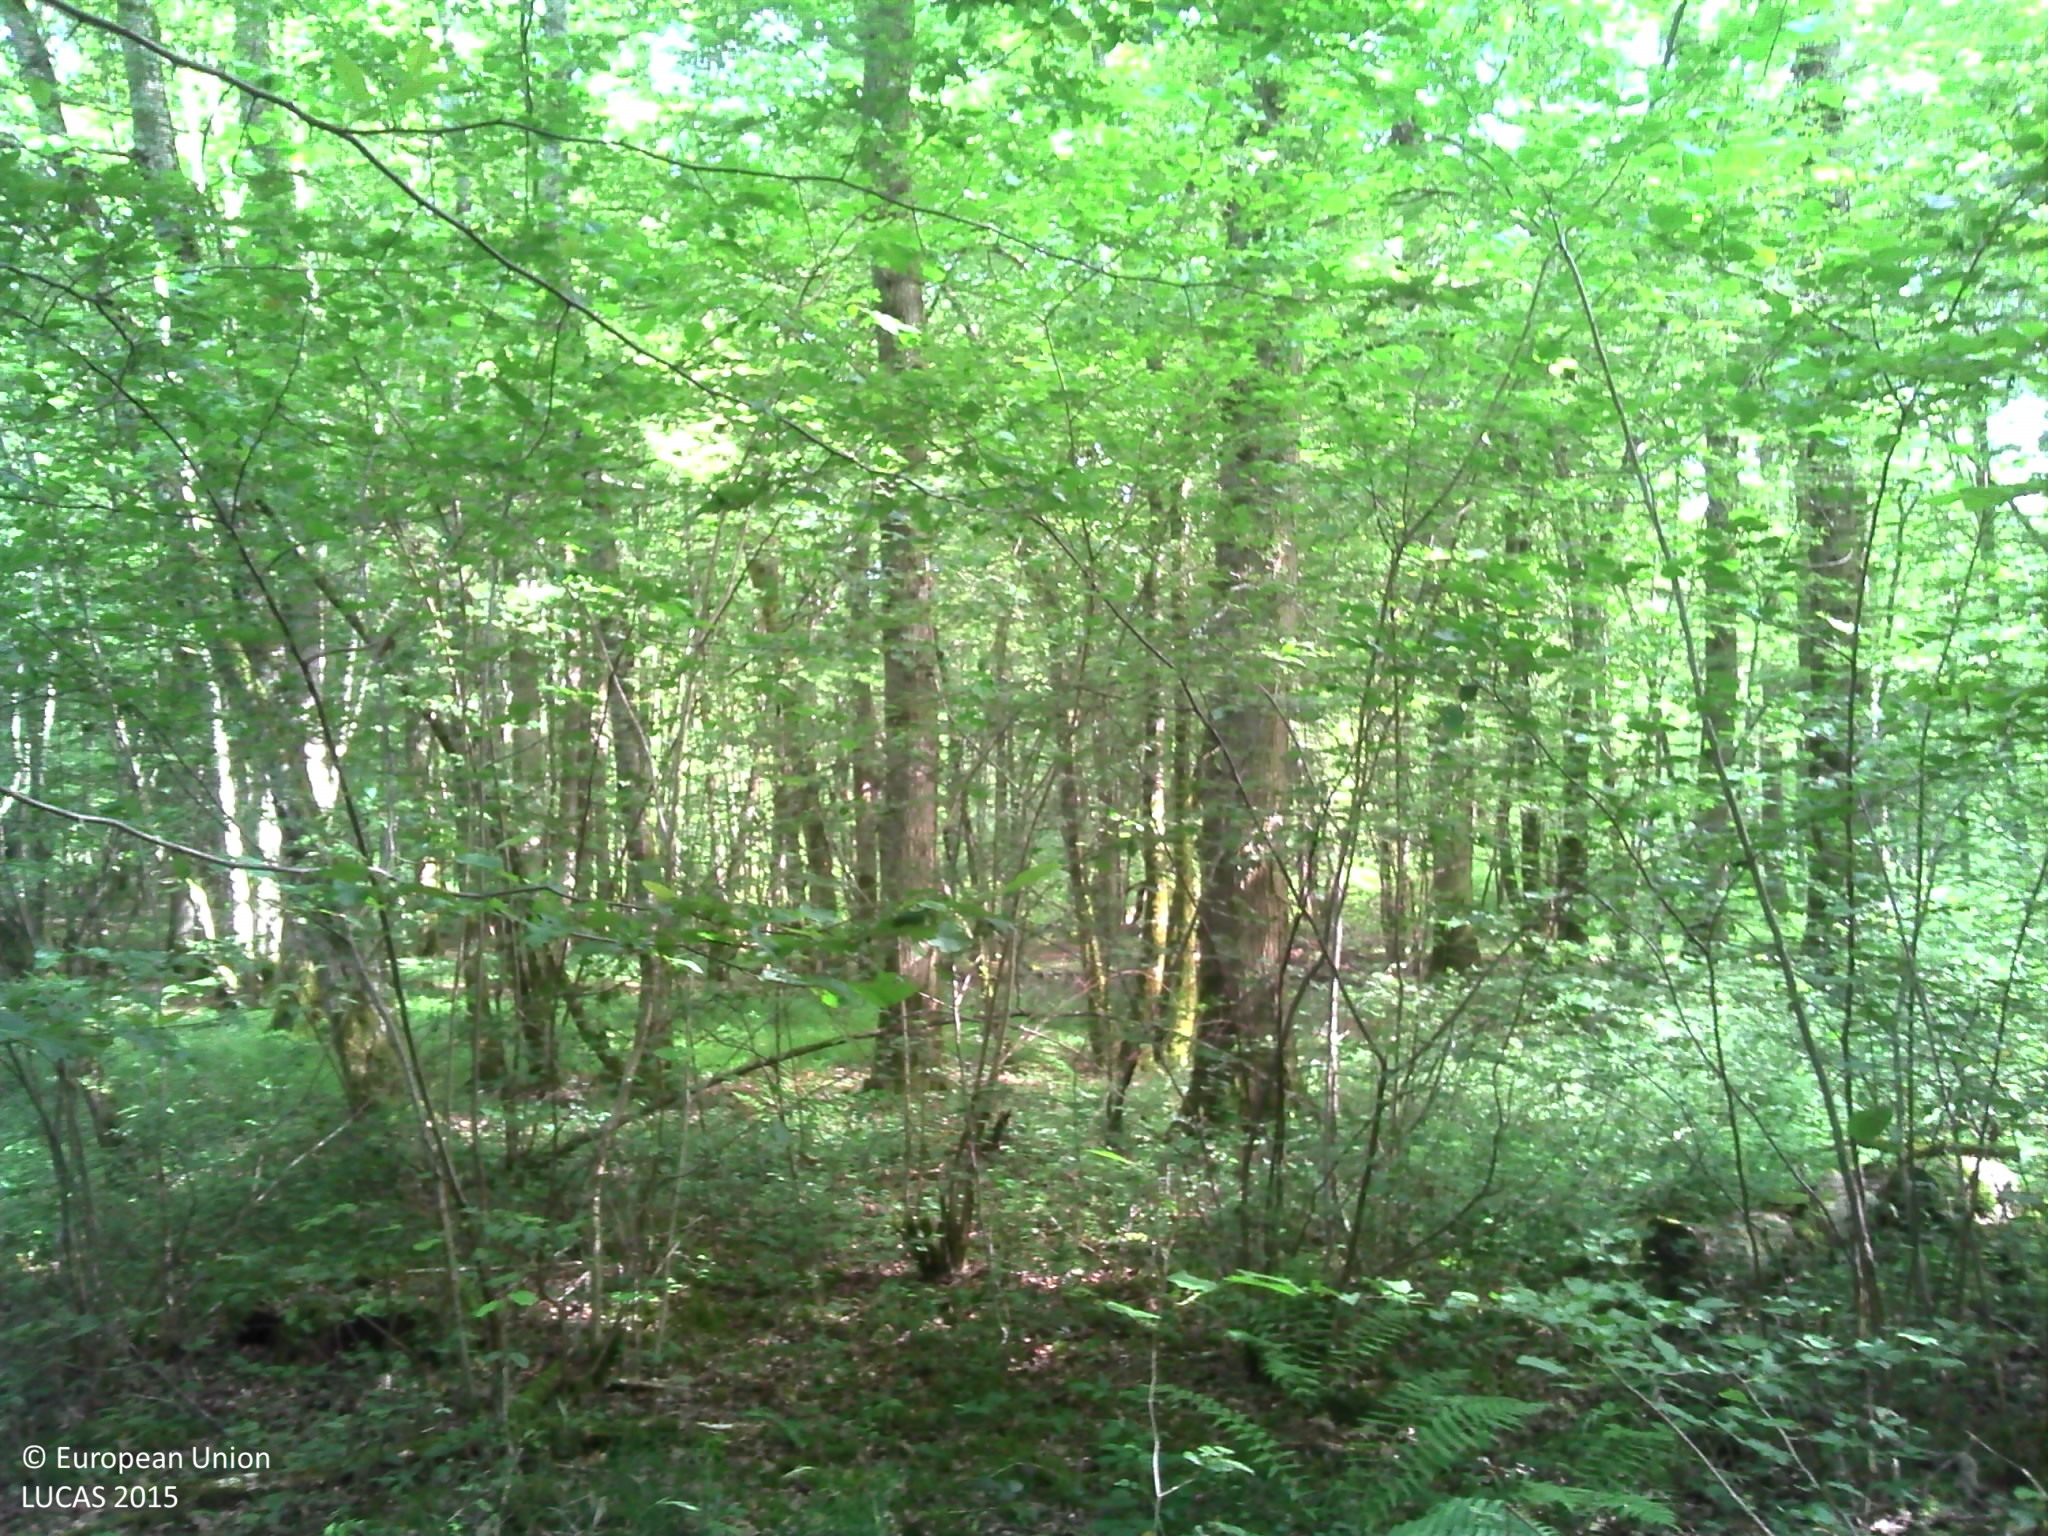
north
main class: Woodland
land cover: Broadleaved woodland
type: mesophytic deciduous forest
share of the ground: > 75 %
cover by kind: broadleaved forest trees 95 %, herbaceous plants 5 %
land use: Forestry
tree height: > 5 m
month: June
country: FR
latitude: 46.8989
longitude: 2.9996
